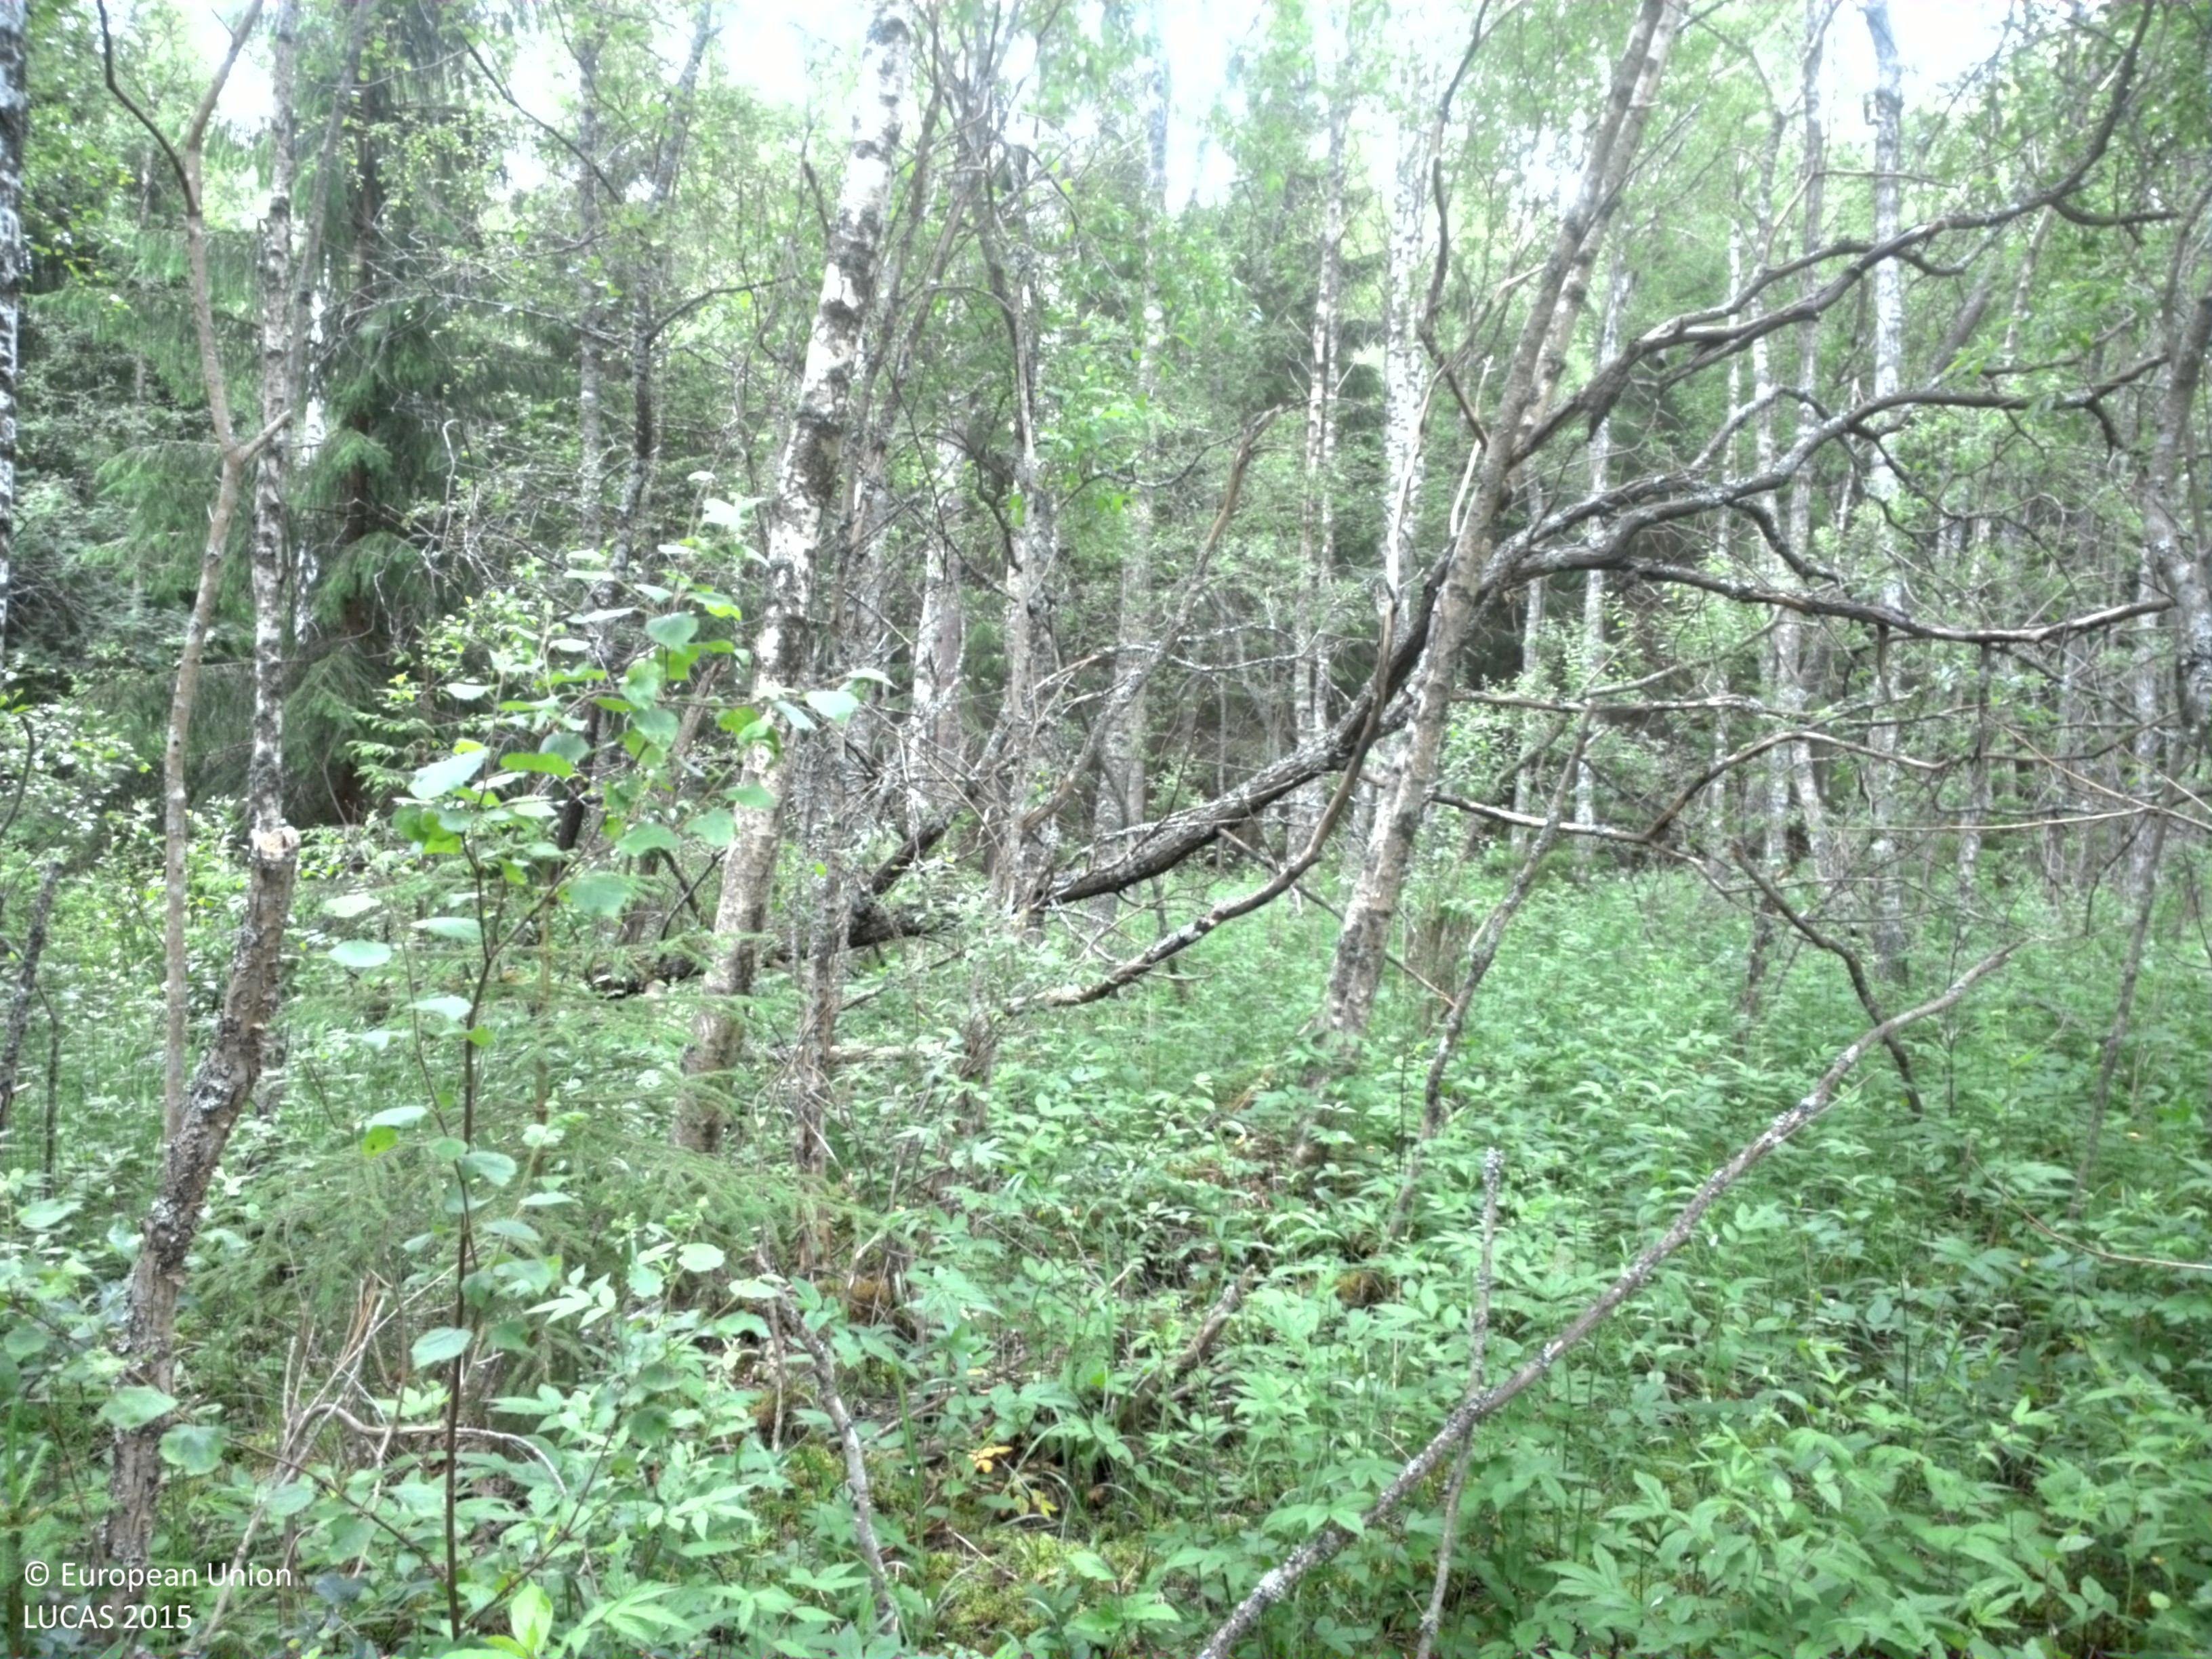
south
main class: Woodland
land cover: Broadleaved woodland
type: hemiboreal forest and nemoral coniferous forest and mixed broadleaved-coniferous forest
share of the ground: > 75 %
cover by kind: broadleaved forest trees 90 %, herbaceous plants 10 %
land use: Forestry
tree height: > 5 m
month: July
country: SE
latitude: 59.9547
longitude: 16.9571
